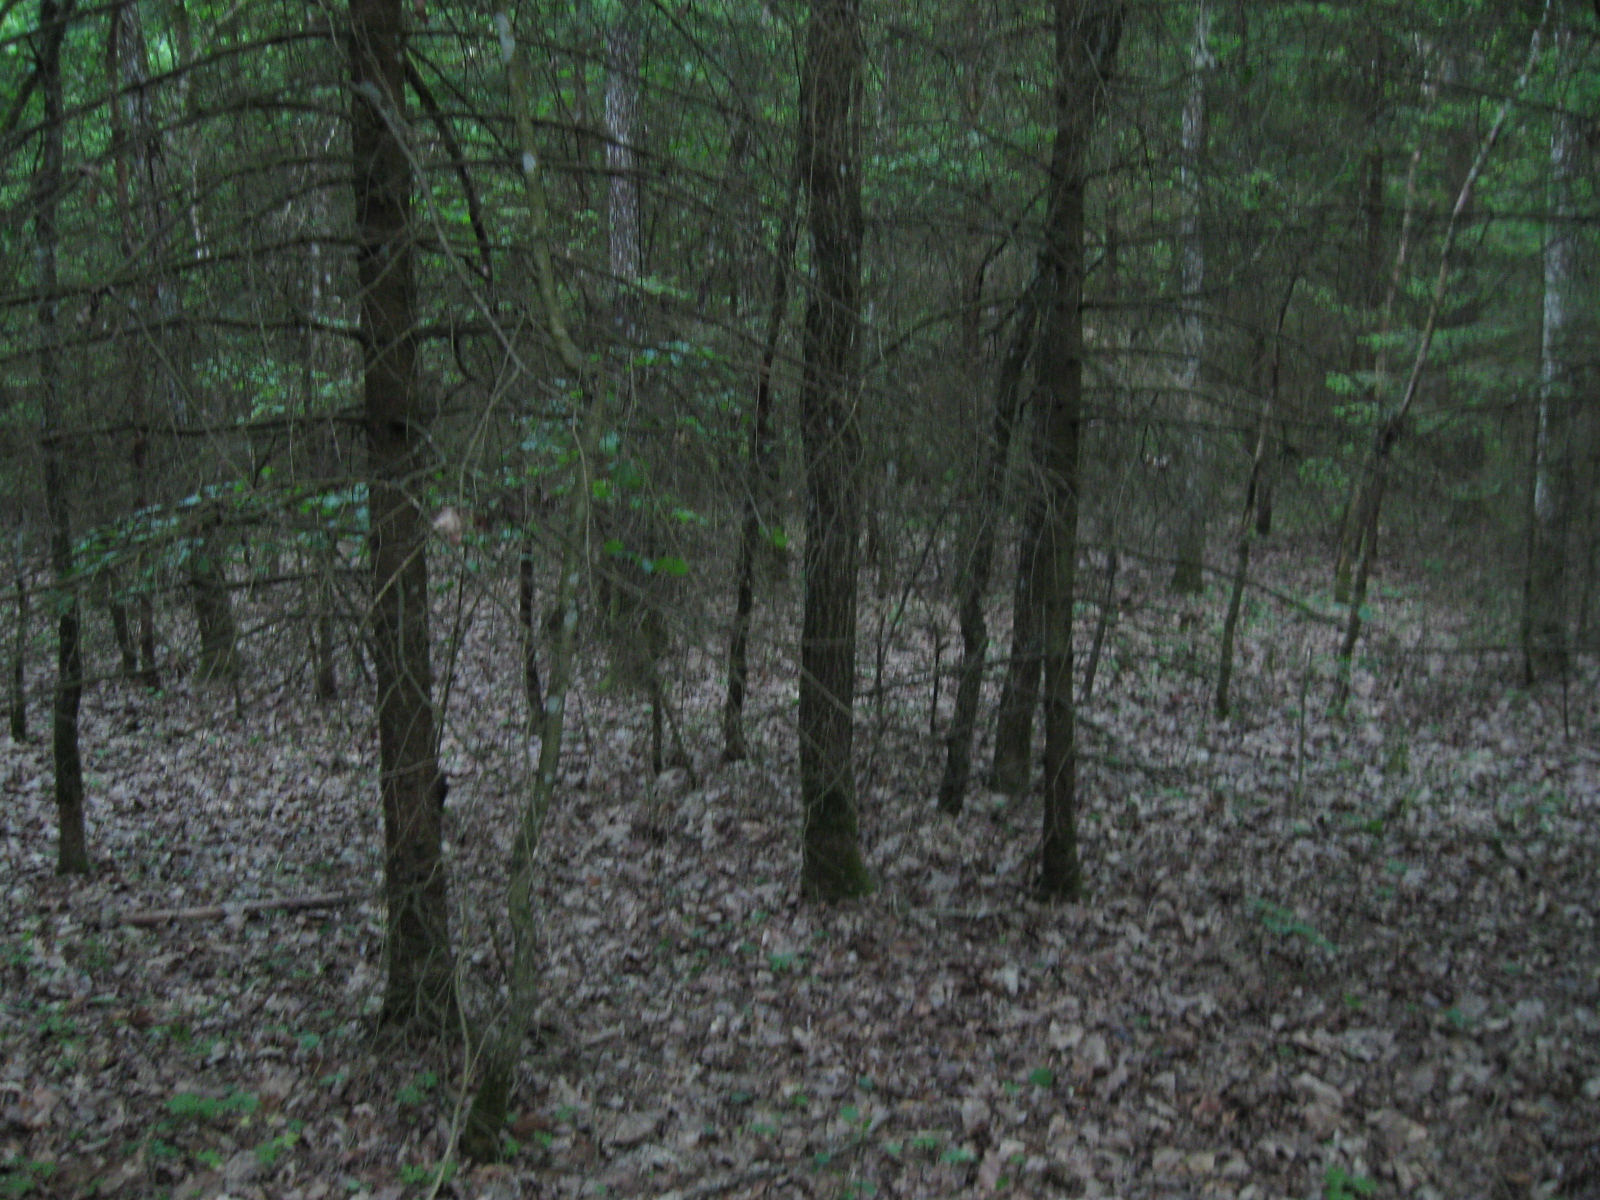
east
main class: Woodland
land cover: Spruce dominated mixed woodland
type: hemiboreal forest and nemoral coniferous forest and mixed broadleaved-coniferous forest
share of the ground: > 75 %
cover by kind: broadleaved forest trees 60 %, coniferous forest trees 40 %
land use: Forestry
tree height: > 5 m
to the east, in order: Spruce dominated mixed woodland
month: June
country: LT
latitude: 54.4548
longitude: 23.9263
